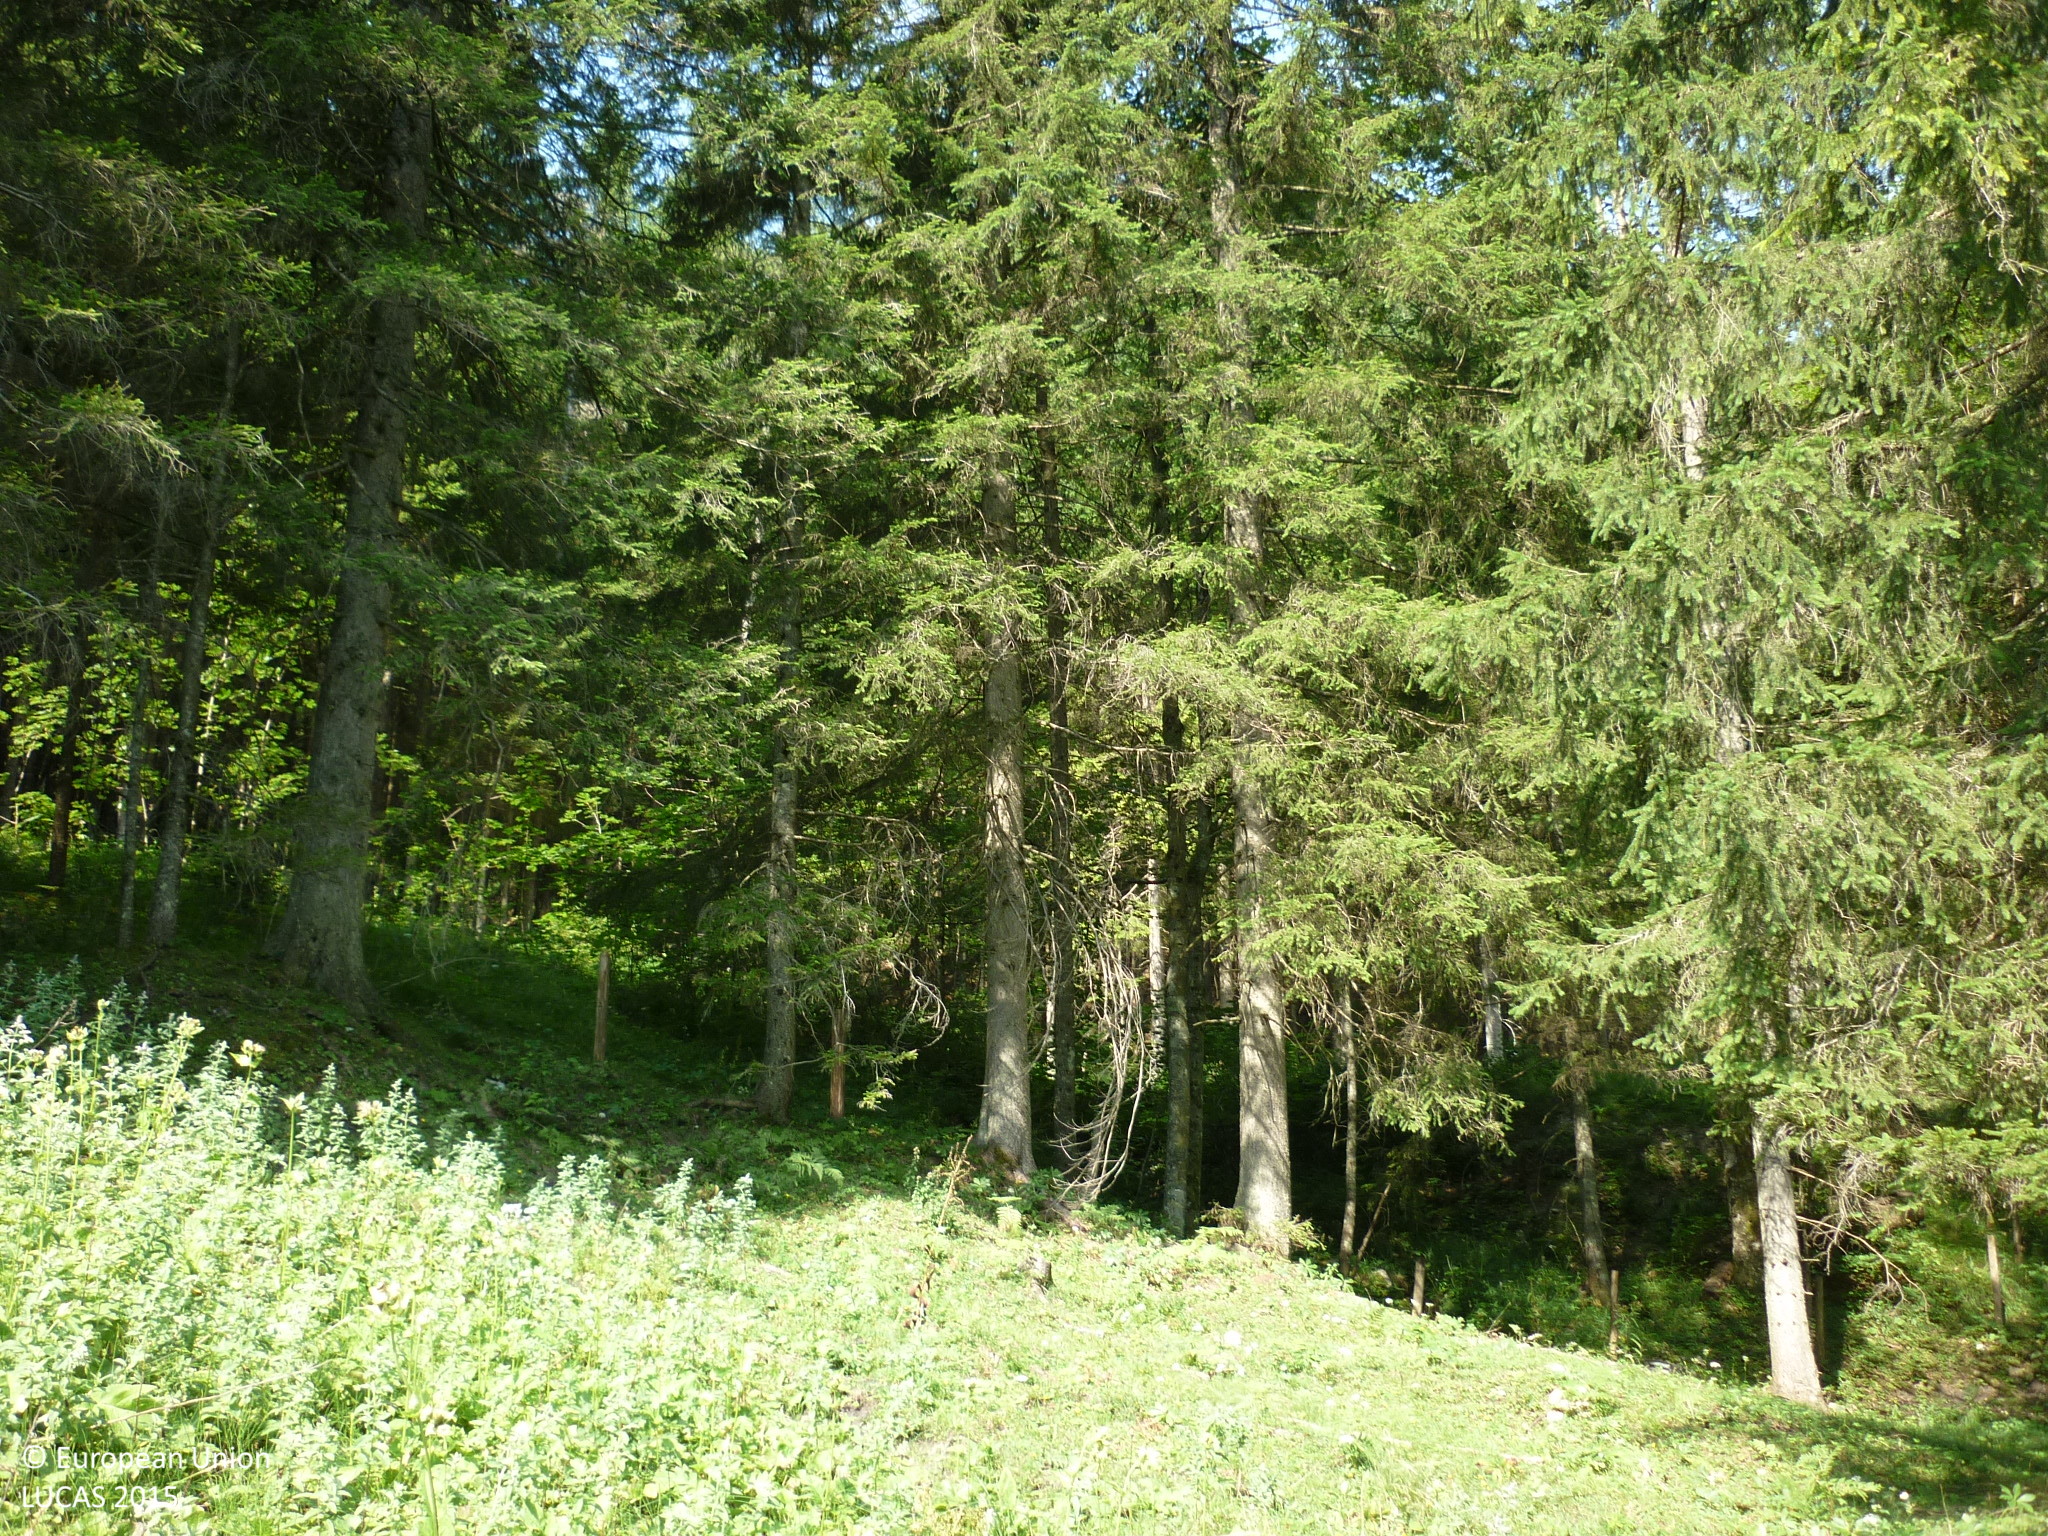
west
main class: Grassland
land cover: Grassland without tree/shrub cover
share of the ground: > 75 %
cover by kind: herbaceous plants 100 %
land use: Agriculture (excluding fallow land and kitchen gardens)
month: August
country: AT
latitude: 47.6679
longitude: 14.3808
